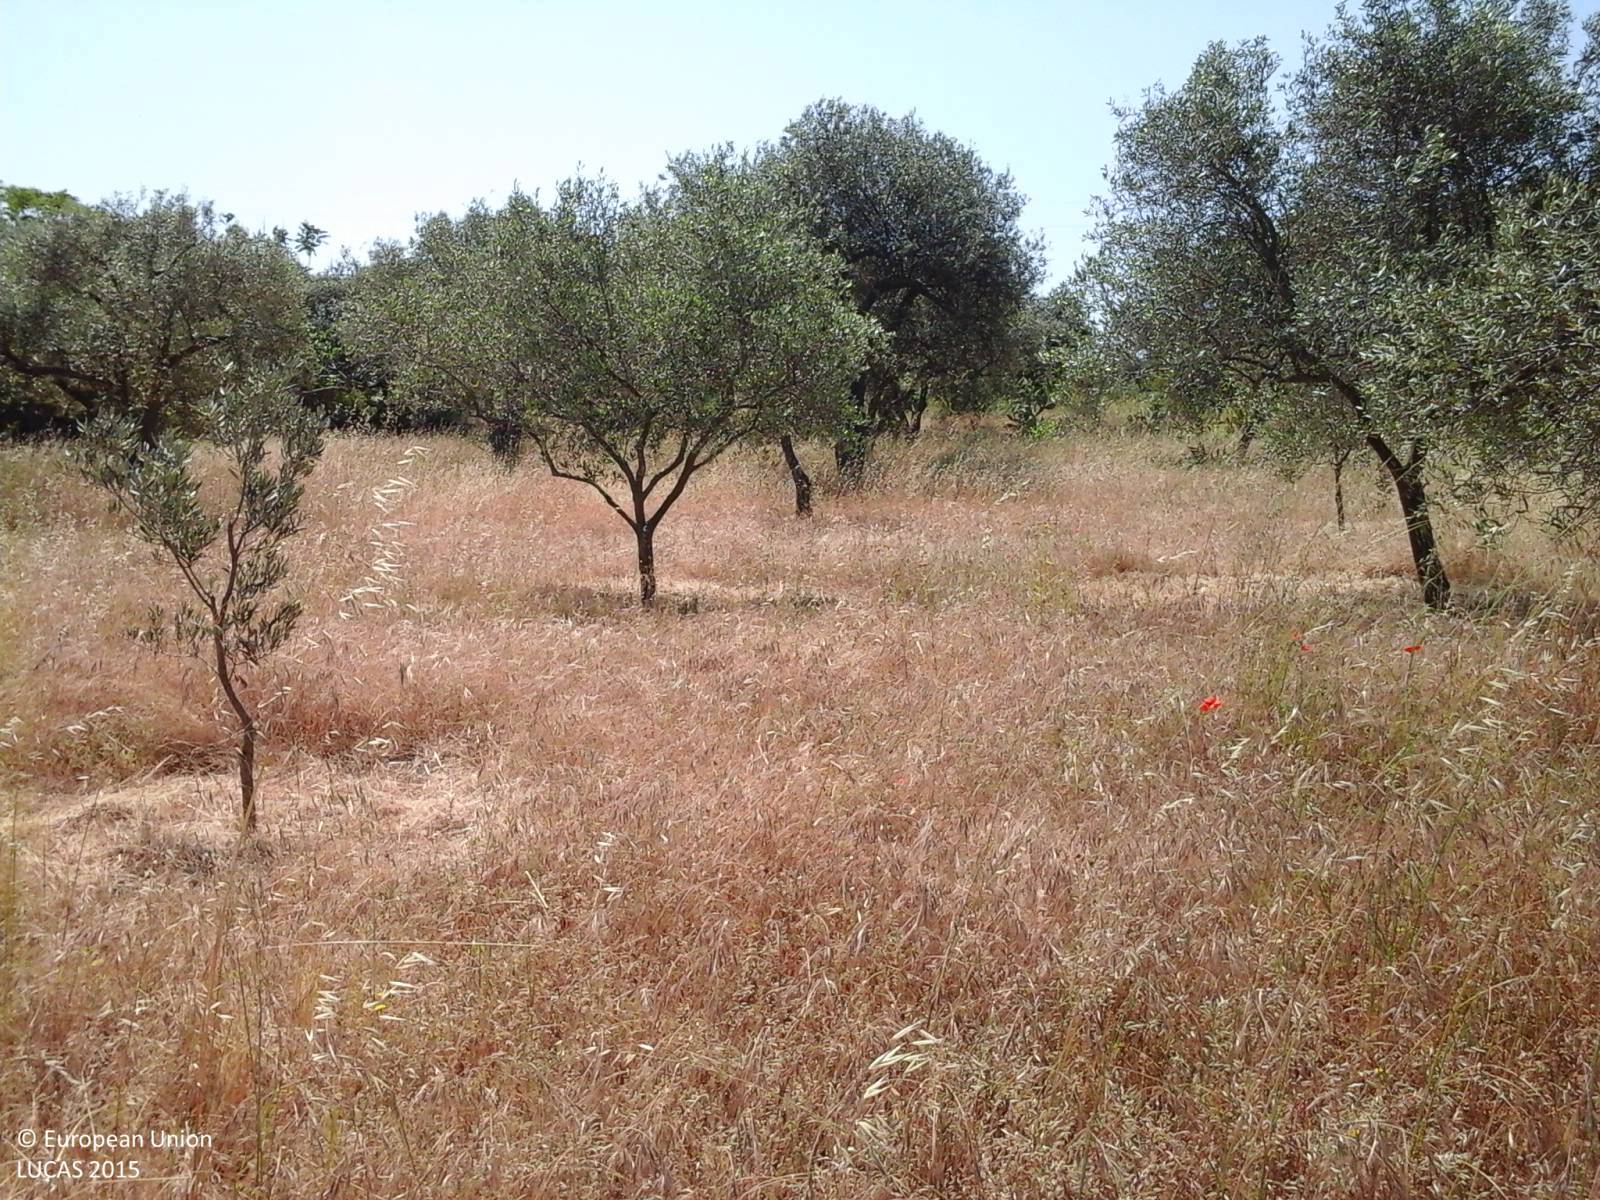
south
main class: Cropland
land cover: Olive groves
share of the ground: 25 - 50 %
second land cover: Spontaneously vegetated surfaces
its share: > 75 %
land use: Agriculture (excluding fallow land and kitchen gardens)
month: May
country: IT
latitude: 40.8180
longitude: 8.5722
